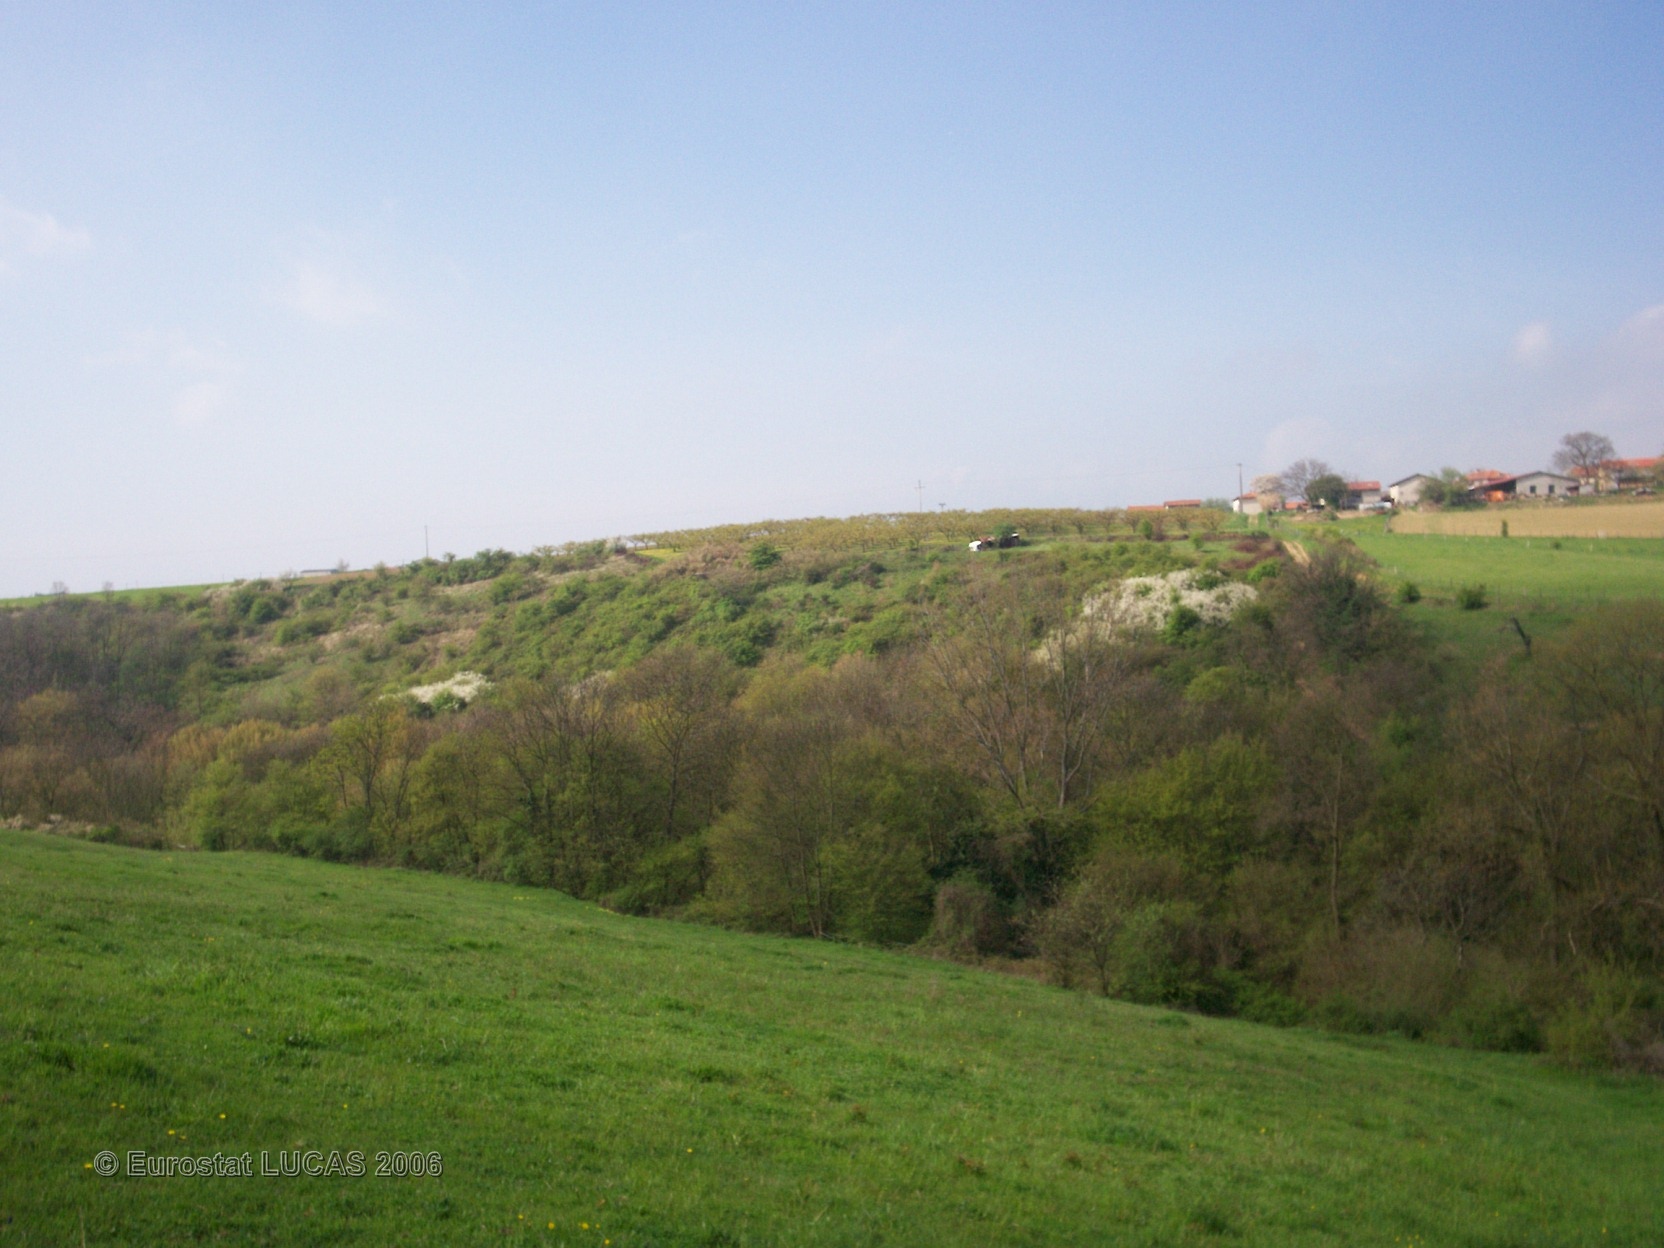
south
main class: Grassland
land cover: Grassland with sparse tree/shrub cover
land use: Agriculture (excluding fallow land and kitchen gardens)
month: April
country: FR
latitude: 45.5025
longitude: 4.7953
